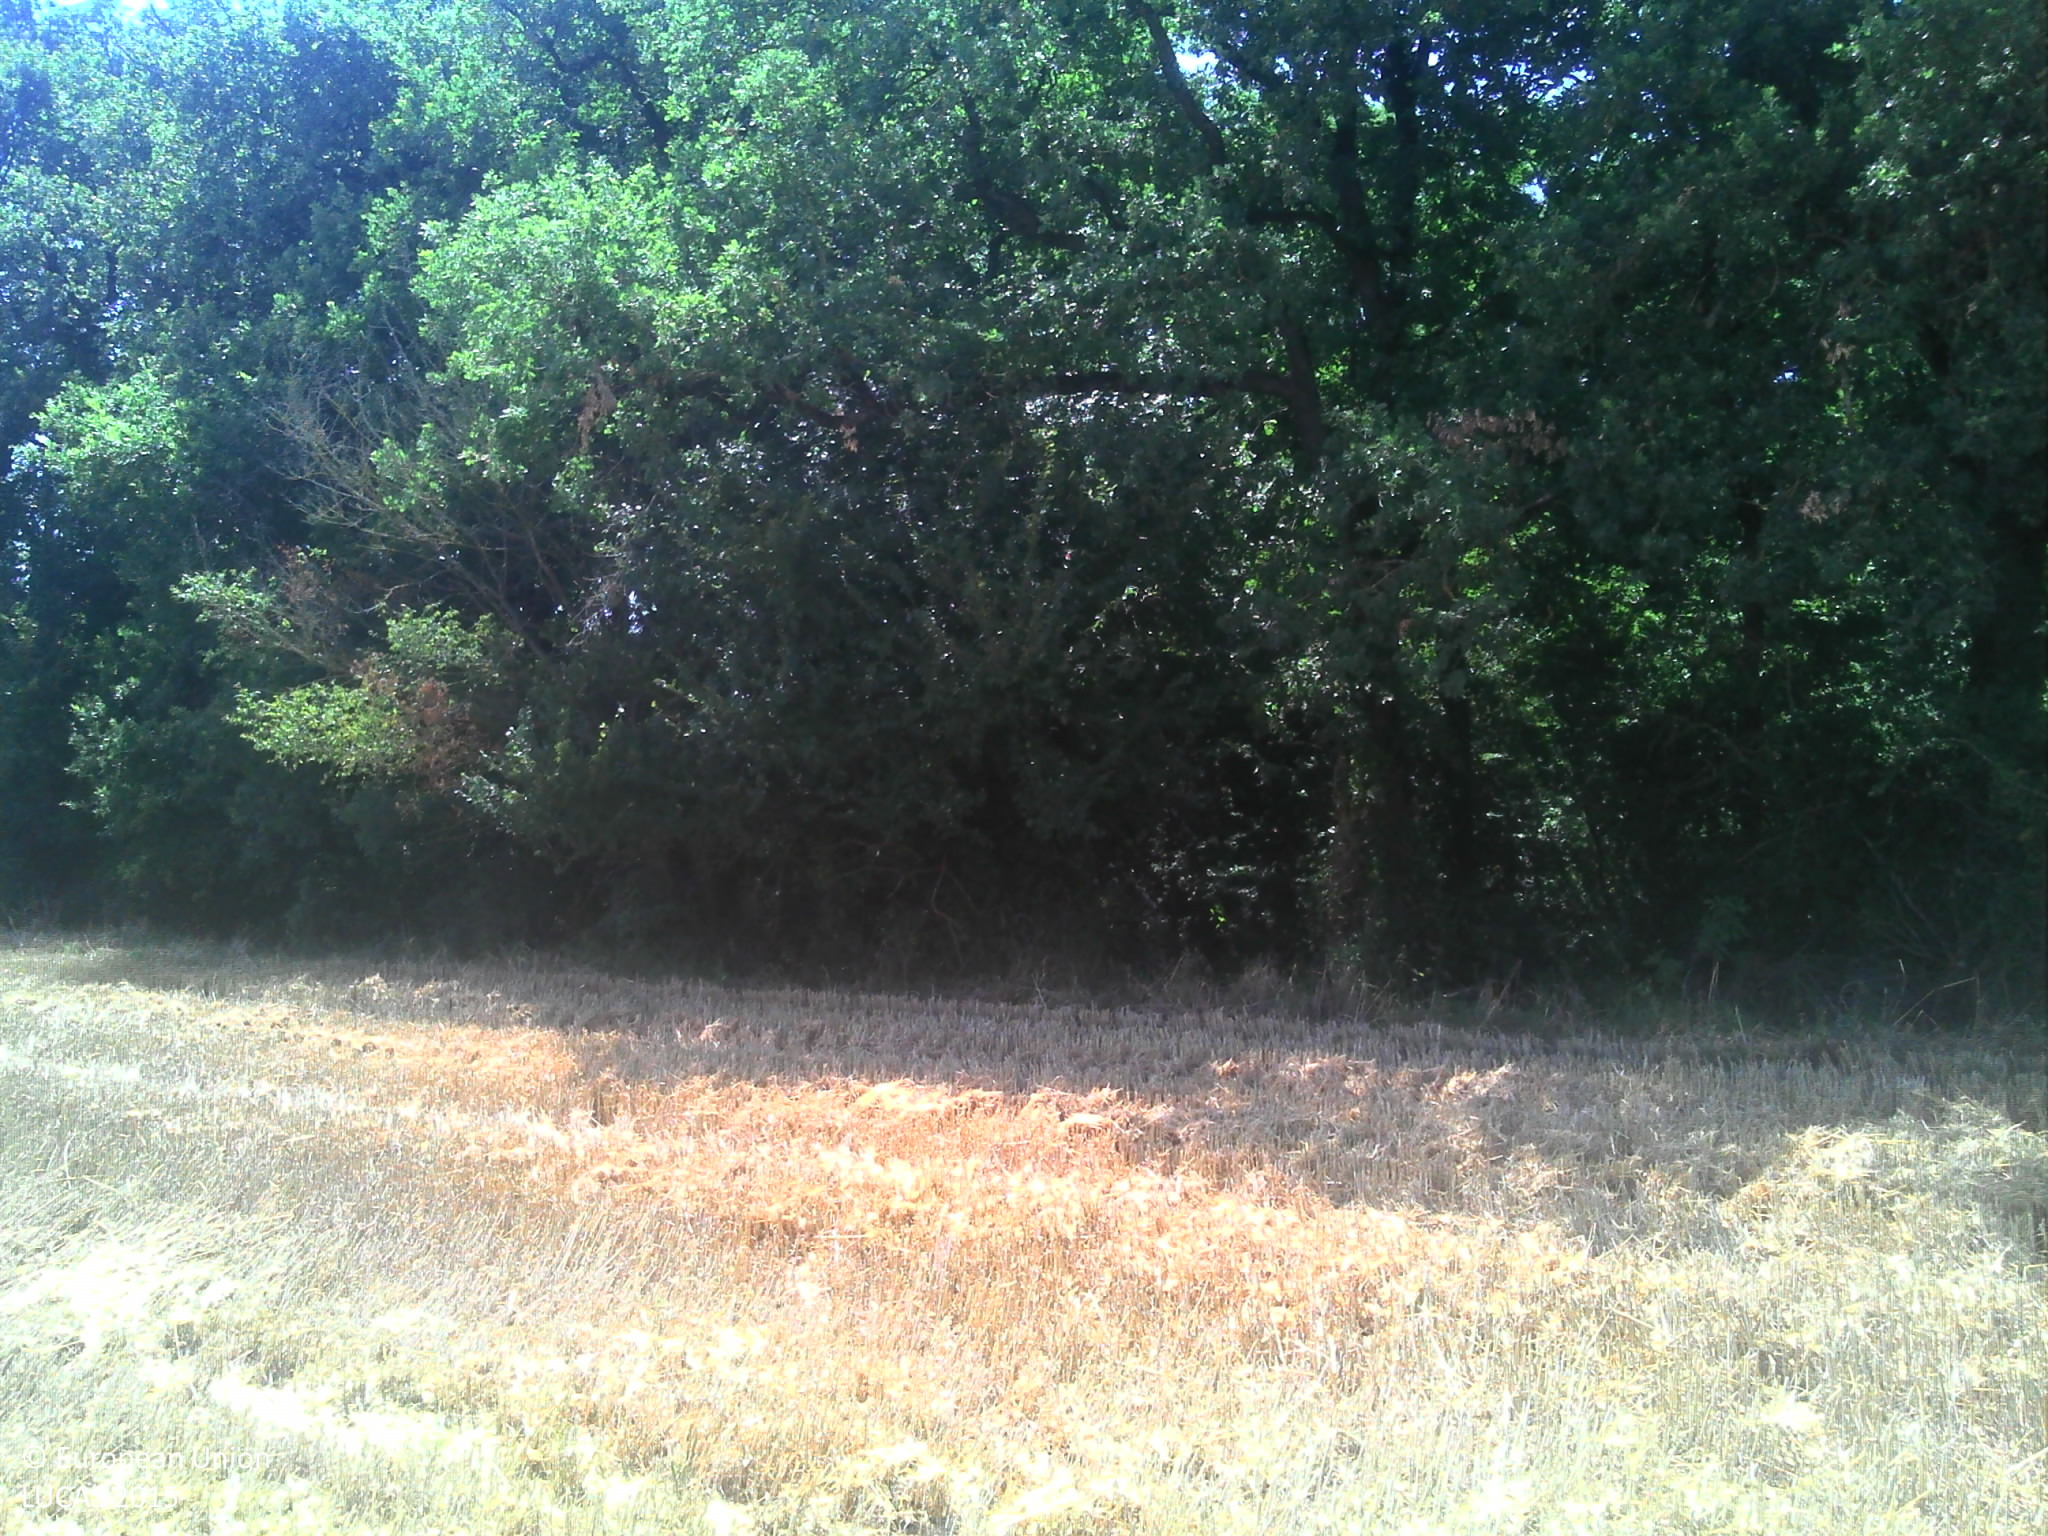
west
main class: Cropland
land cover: Durum wheat
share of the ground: > 75 %
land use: Agriculture (excluding fallow land and kitchen gardens)
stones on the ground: < 10 %
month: July
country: FR
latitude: 43.5061
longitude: 1.4316
